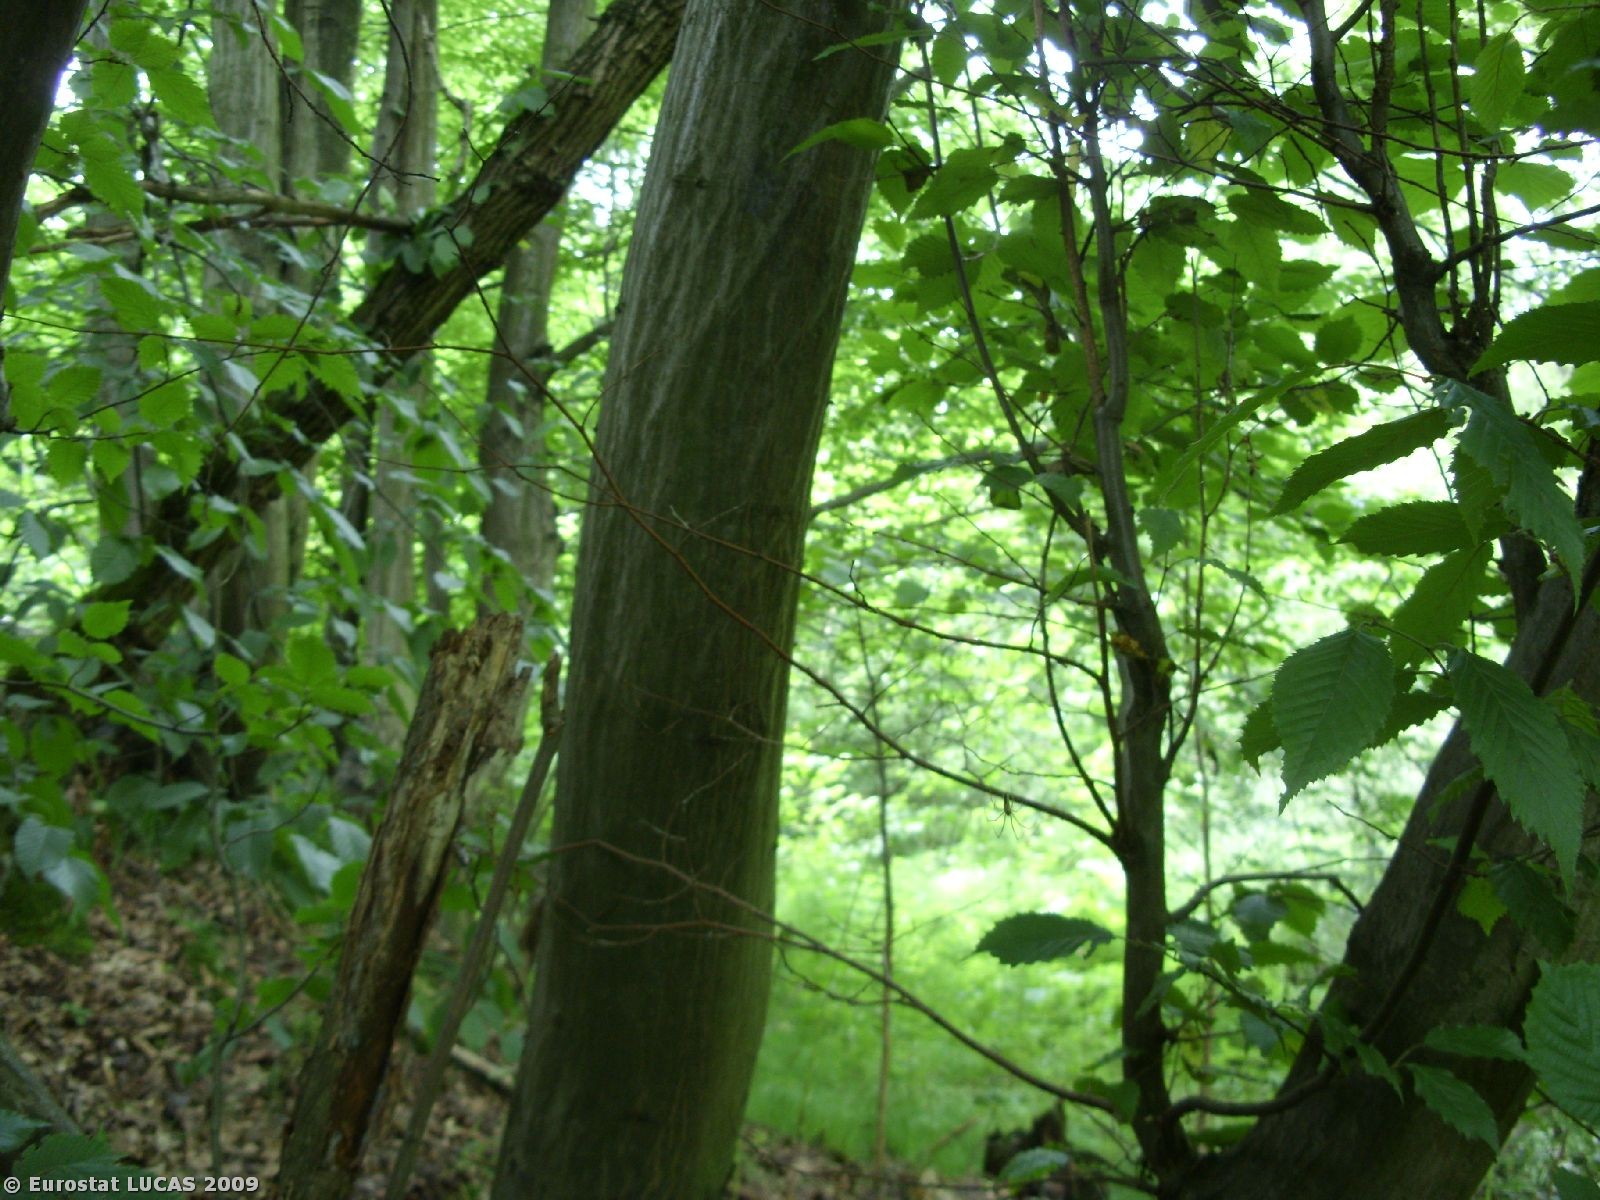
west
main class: Woodland
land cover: Broadleaved woodland
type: mesophytic deciduous forest
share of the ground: > 75 %
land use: Unused
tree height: > 5 m
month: June
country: PL
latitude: 49.8371
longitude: 20.1698
